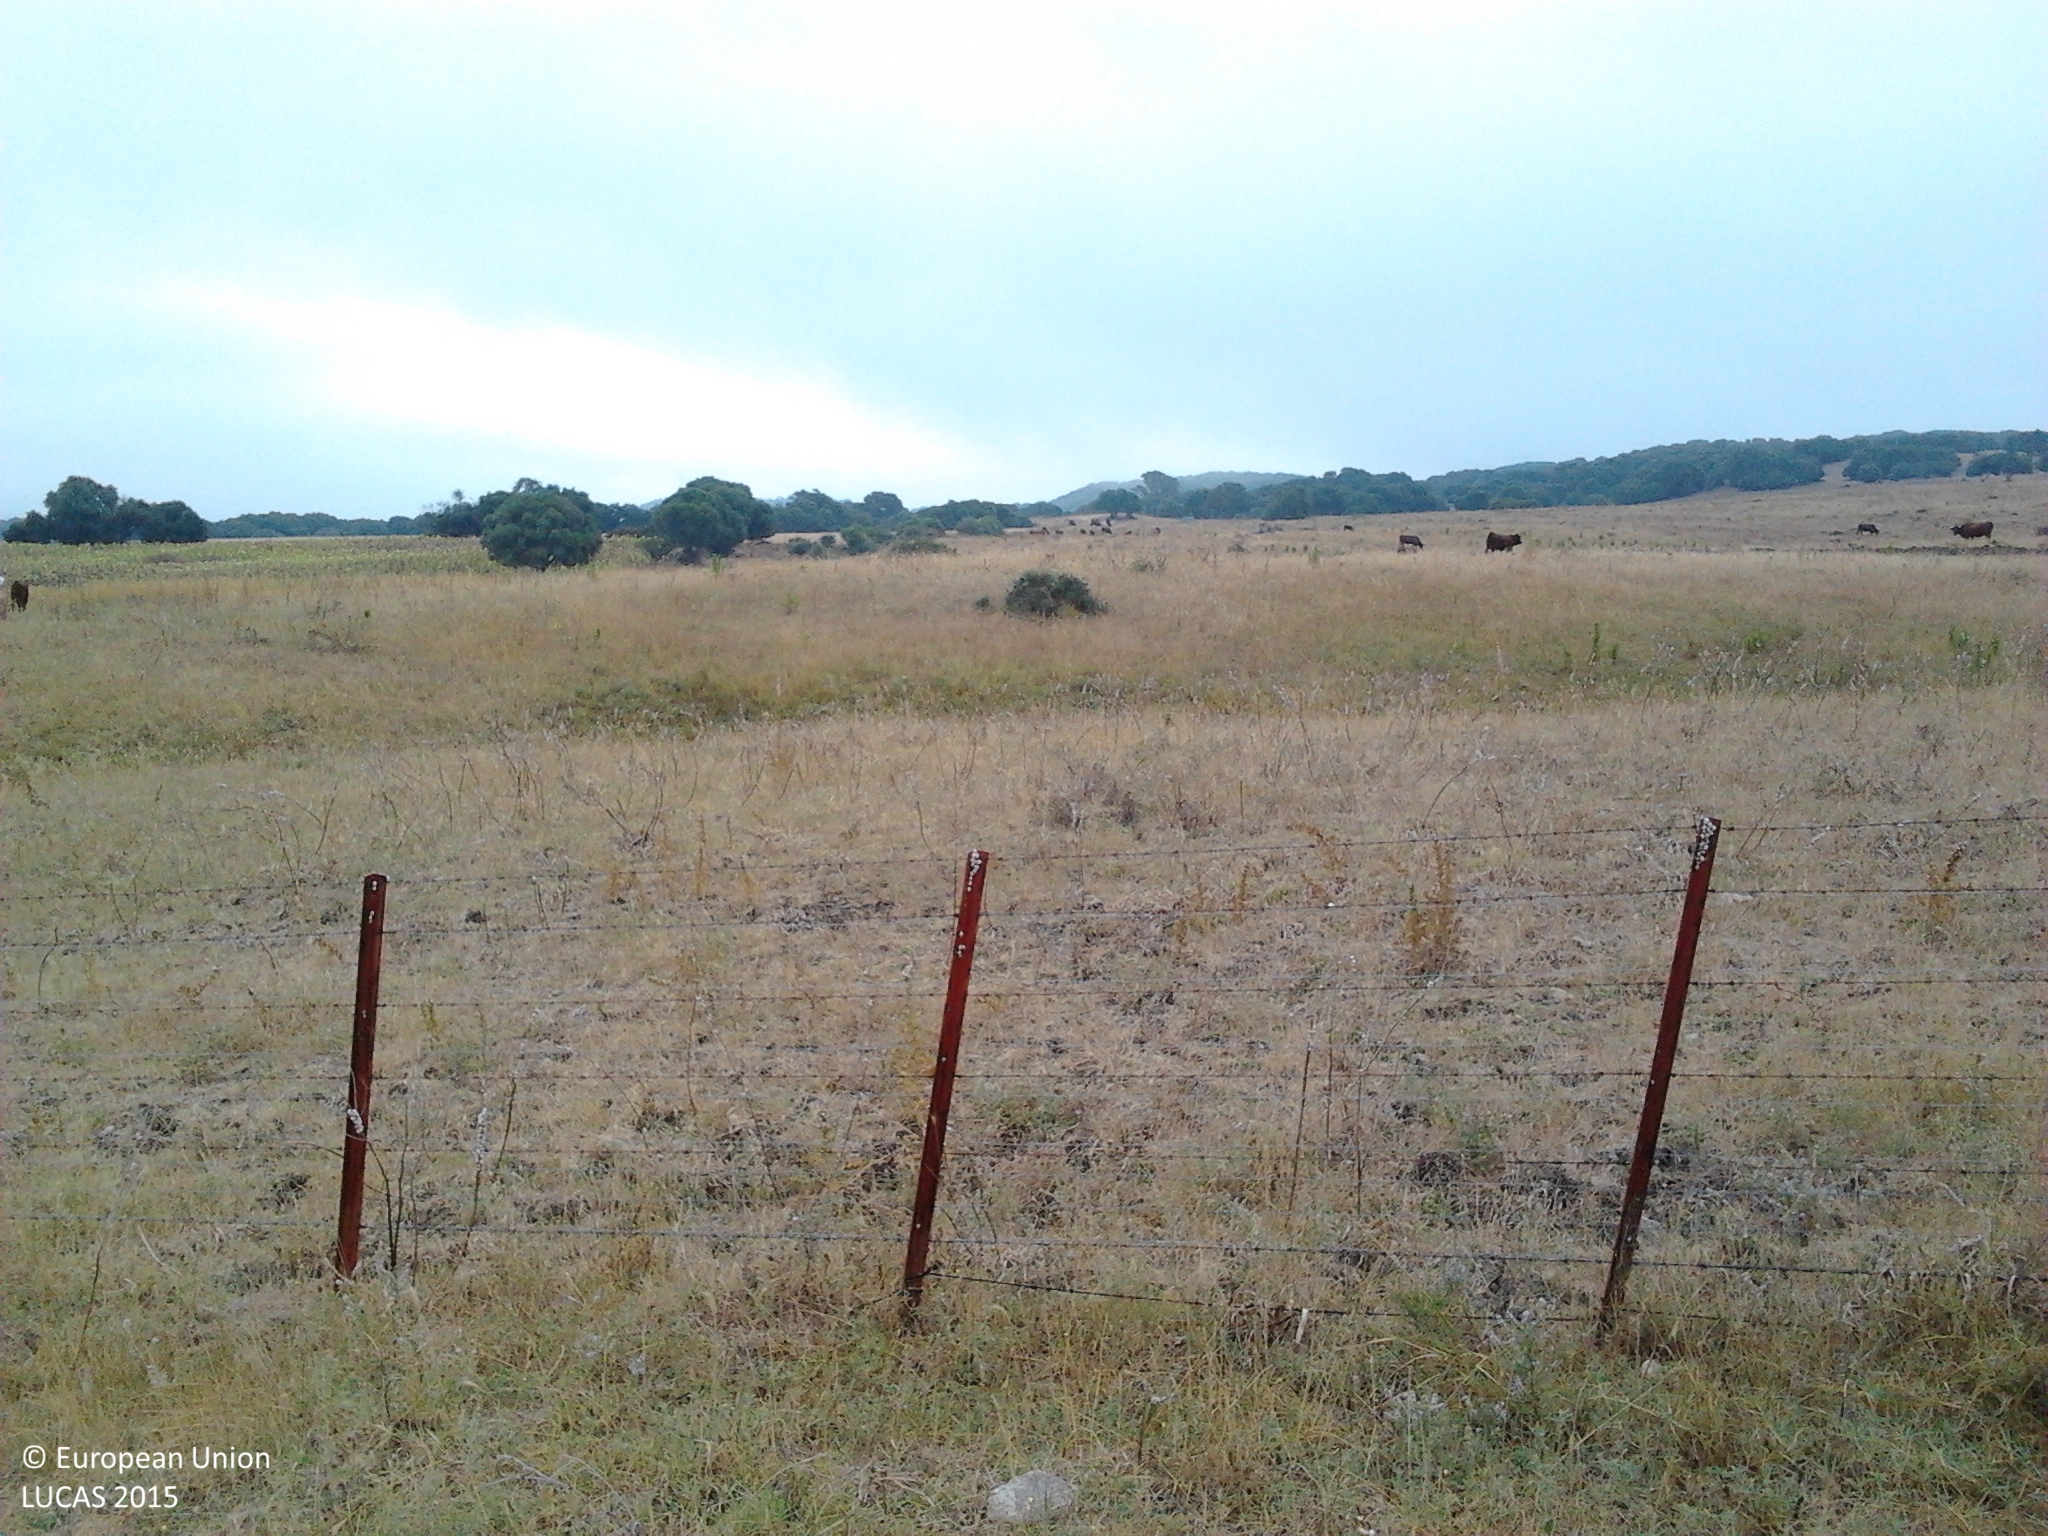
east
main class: Grassland
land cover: Grassland without tree/shrub cover
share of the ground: > 75 %
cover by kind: herbaceous plants 100 %
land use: Agriculture (excluding fallow land and kitchen gardens)
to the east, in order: Grassland without tree/shrub cover; Tracks; Grassland without tree/shrub cover; Other structural elements; Grassland without tree/shrub cover
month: July
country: ES
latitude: 36.3561
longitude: -5.8363
